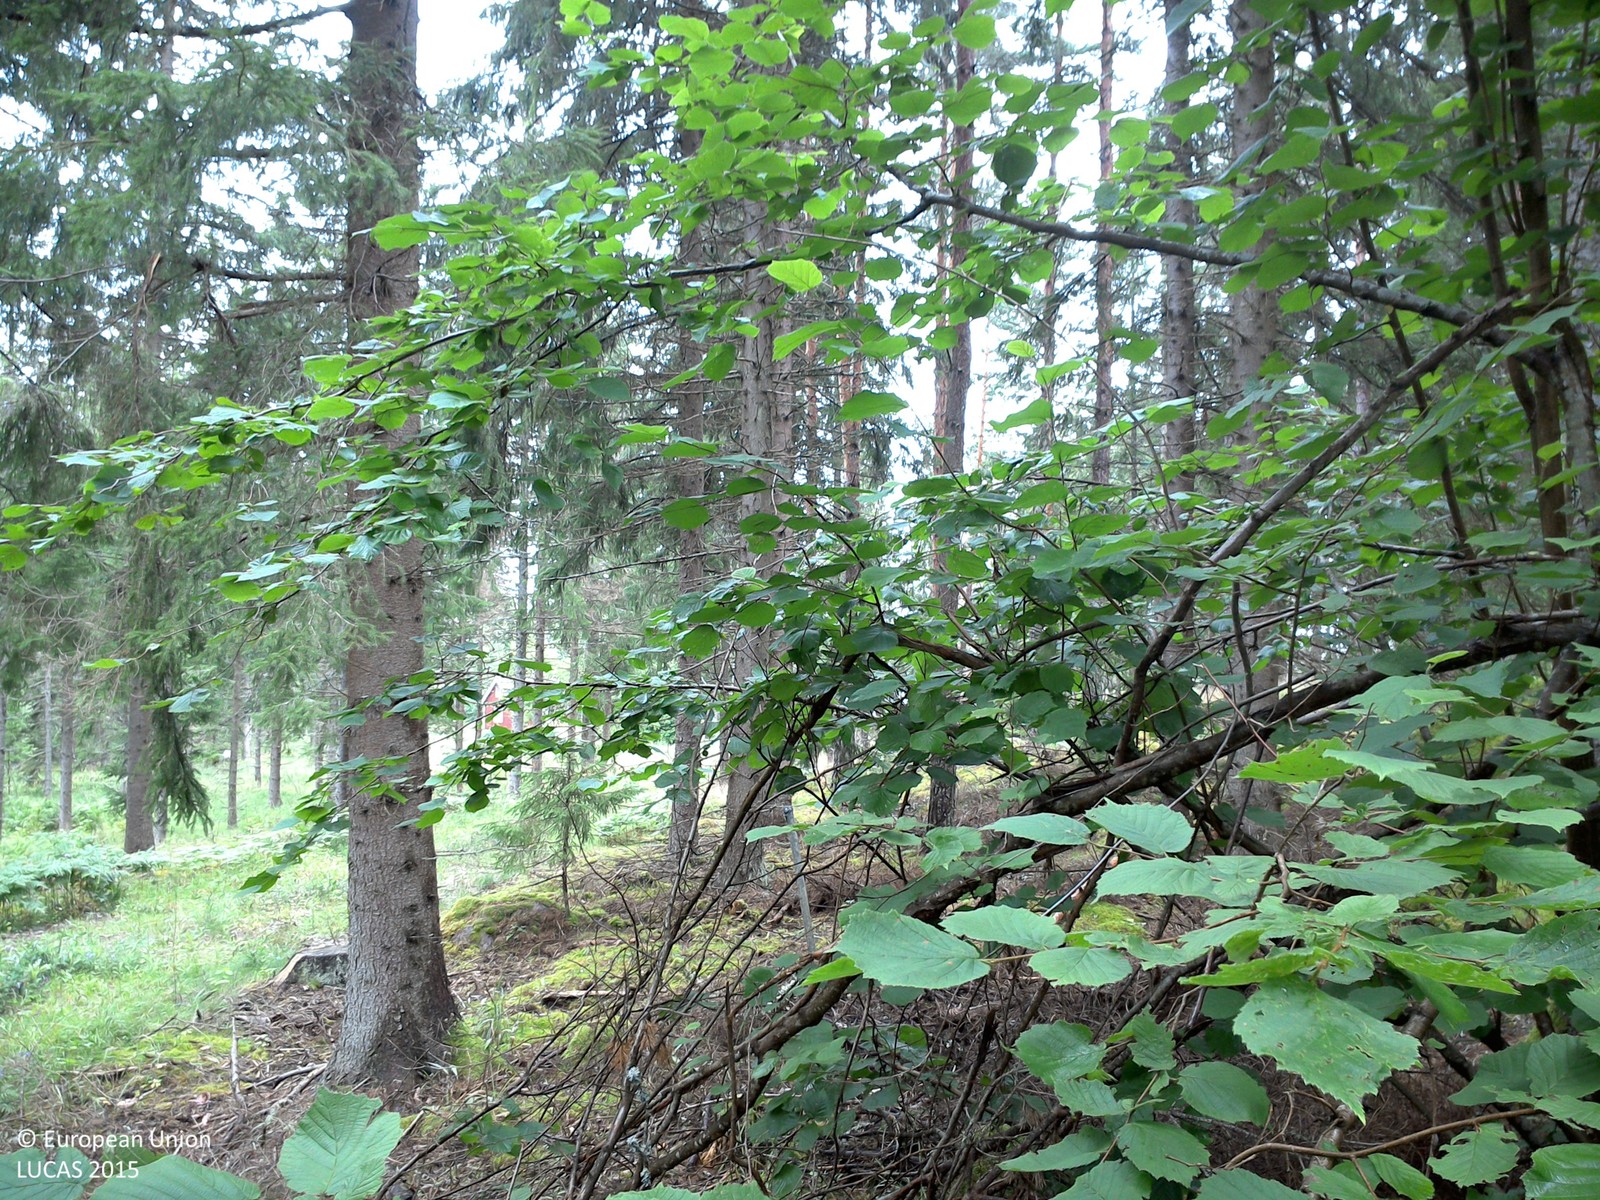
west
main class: Woodland
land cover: Spruce dominated coniferous woodland
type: boreal forest
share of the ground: 50 - 75 %
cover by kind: coniferous forest trees 60 %, herbaceous plants 25 %, lichens and mosses 10 %, broadleaved forest trees 5 %
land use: Forestry
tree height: > 5 m
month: August
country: SE
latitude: 58.2375
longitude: 15.3940
